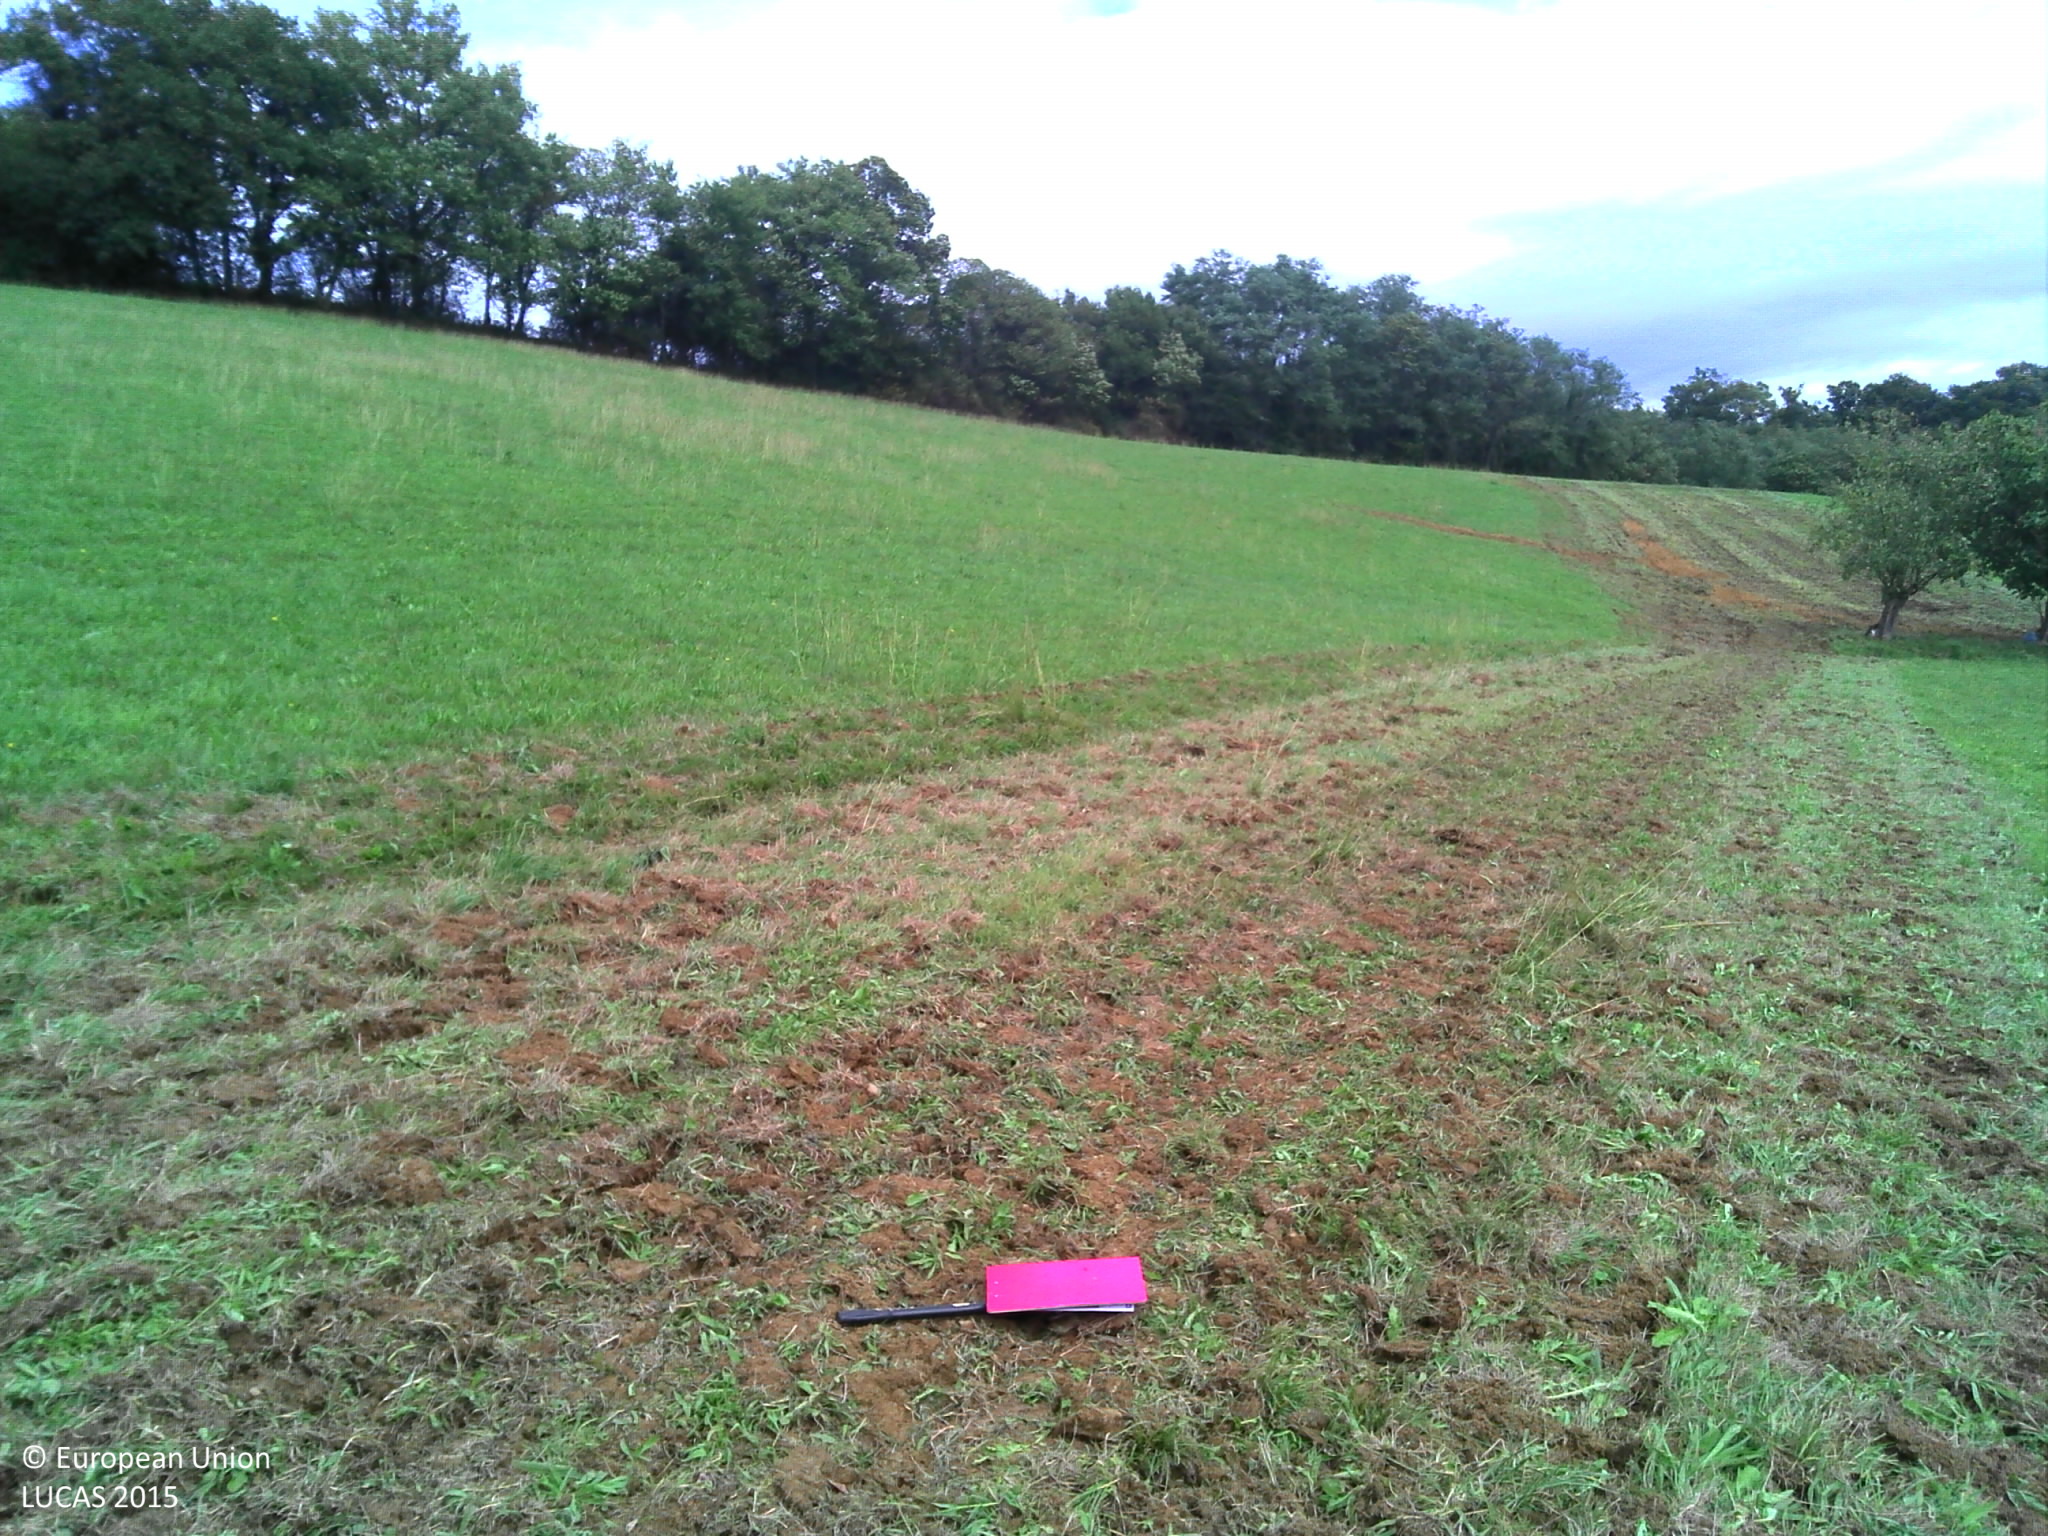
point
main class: Grassland
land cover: Grassland without tree/shrub cover
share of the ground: > 75 %
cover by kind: herbaceous plants 90 %, unconsolidated bare surface 10 %
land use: Agriculture (excluding fallow land and kitchen gardens)
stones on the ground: < 10 %
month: September
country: FR
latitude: 43.2922
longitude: -0.6457
